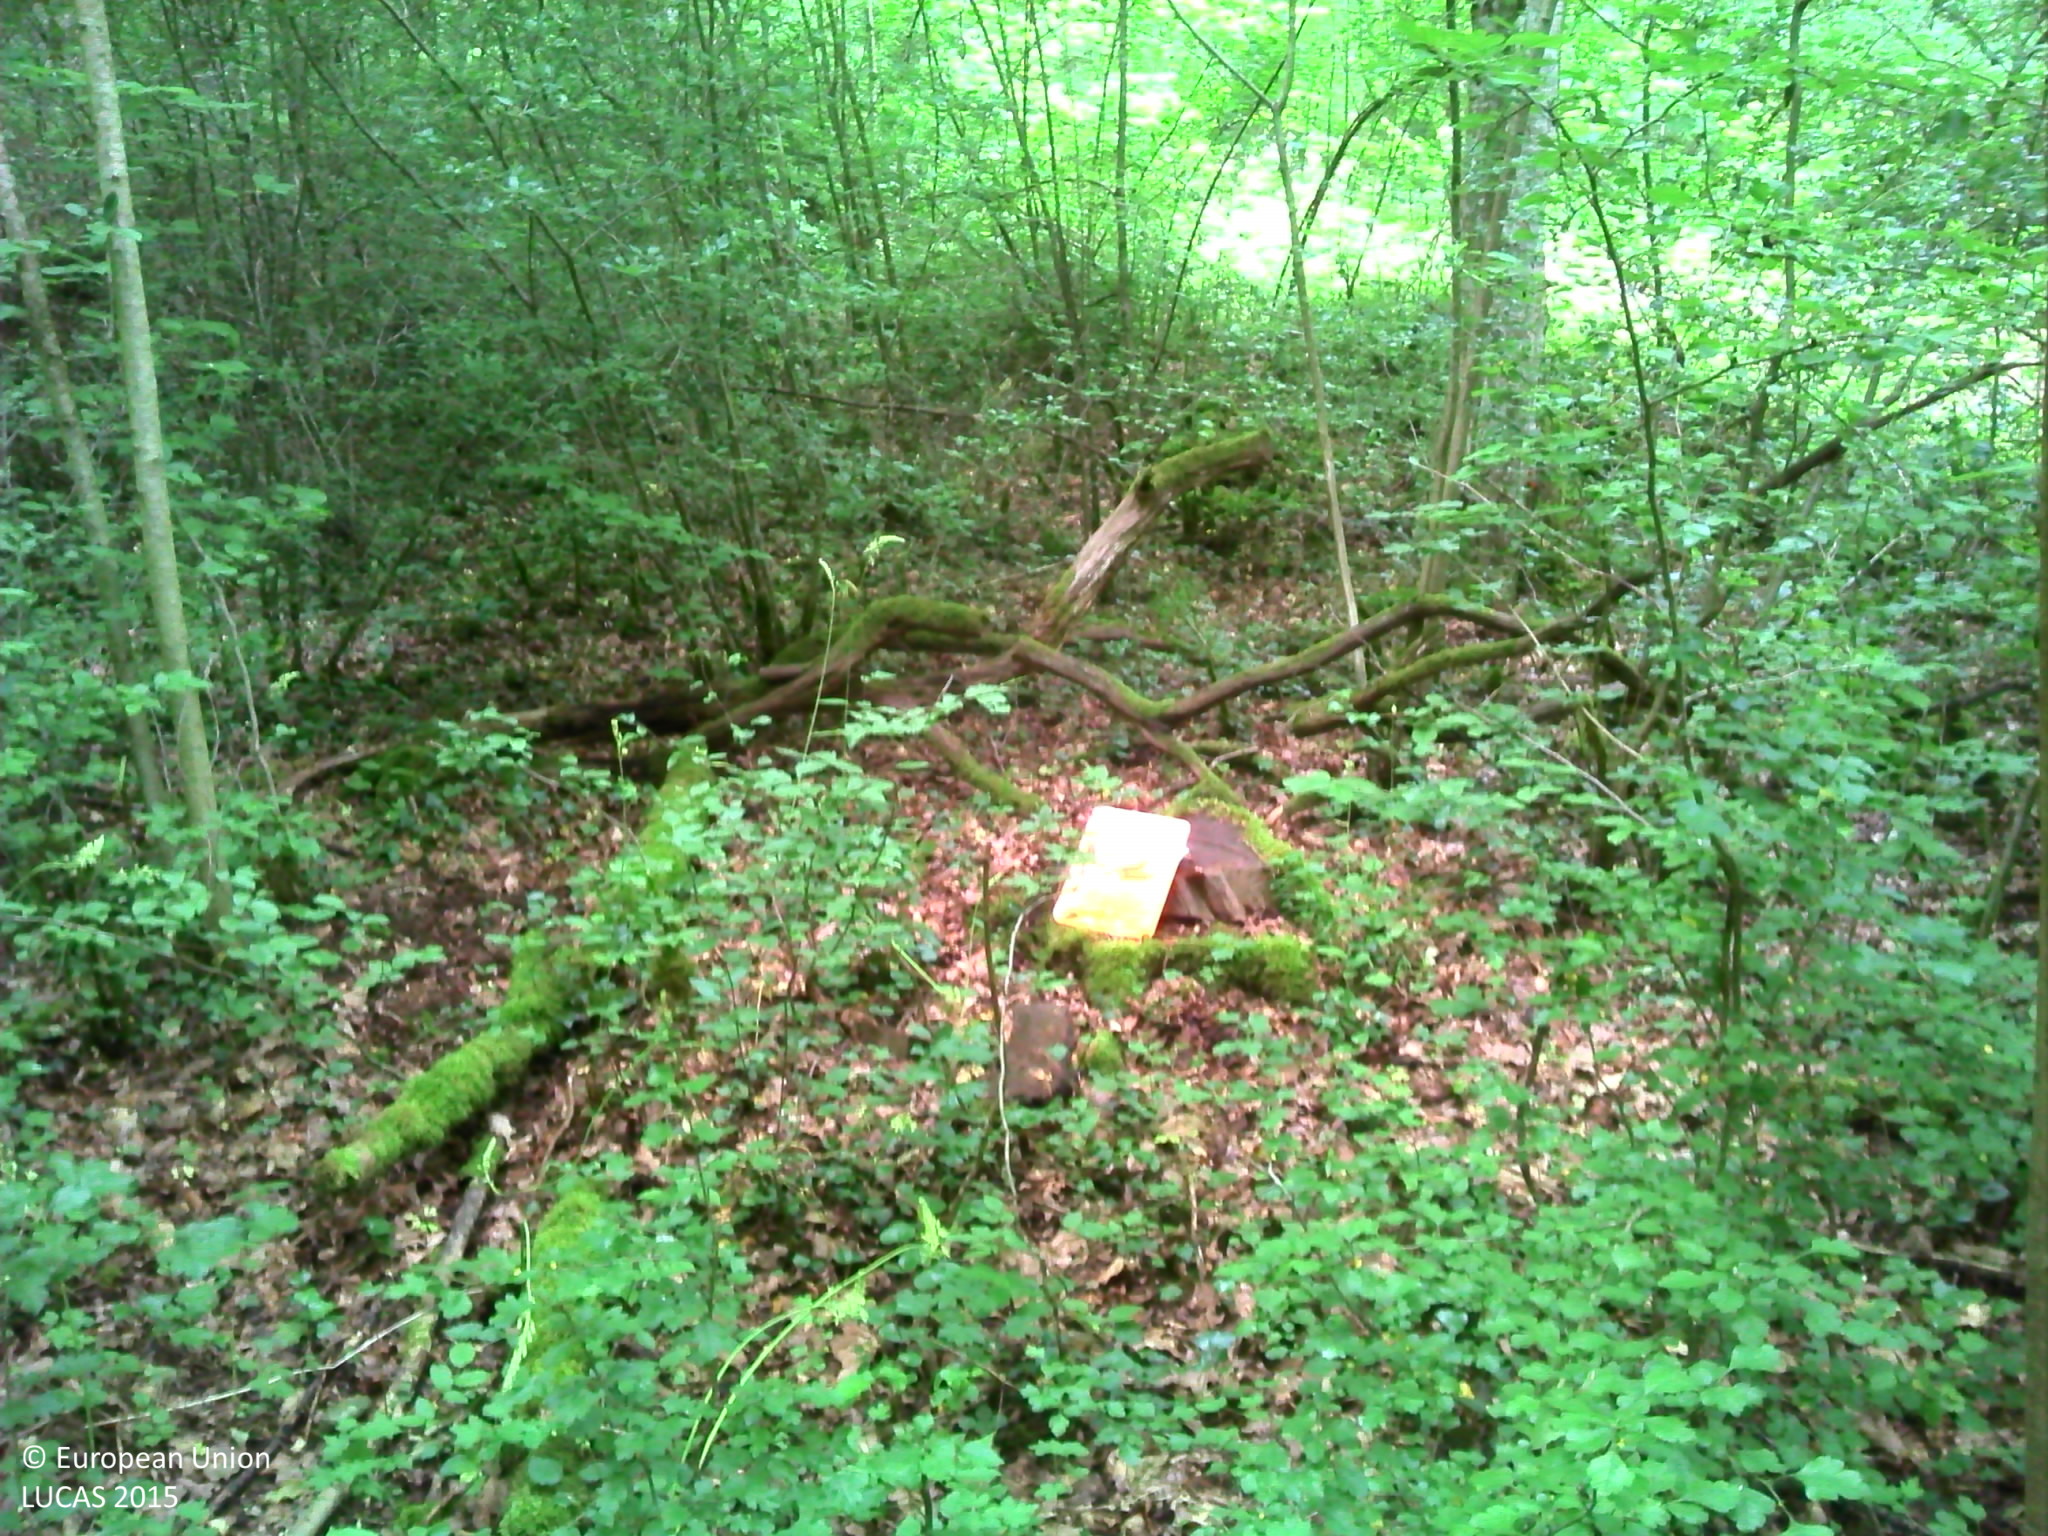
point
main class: Woodland
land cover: Broadleaved woodland
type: mesophytic deciduous forest
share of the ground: > 75 %
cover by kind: broadleaved forest trees 95 %, lichens and mosses 5 %
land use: Forestry
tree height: > 5 m
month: June
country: FR
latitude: 48.7111
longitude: 6.0451
